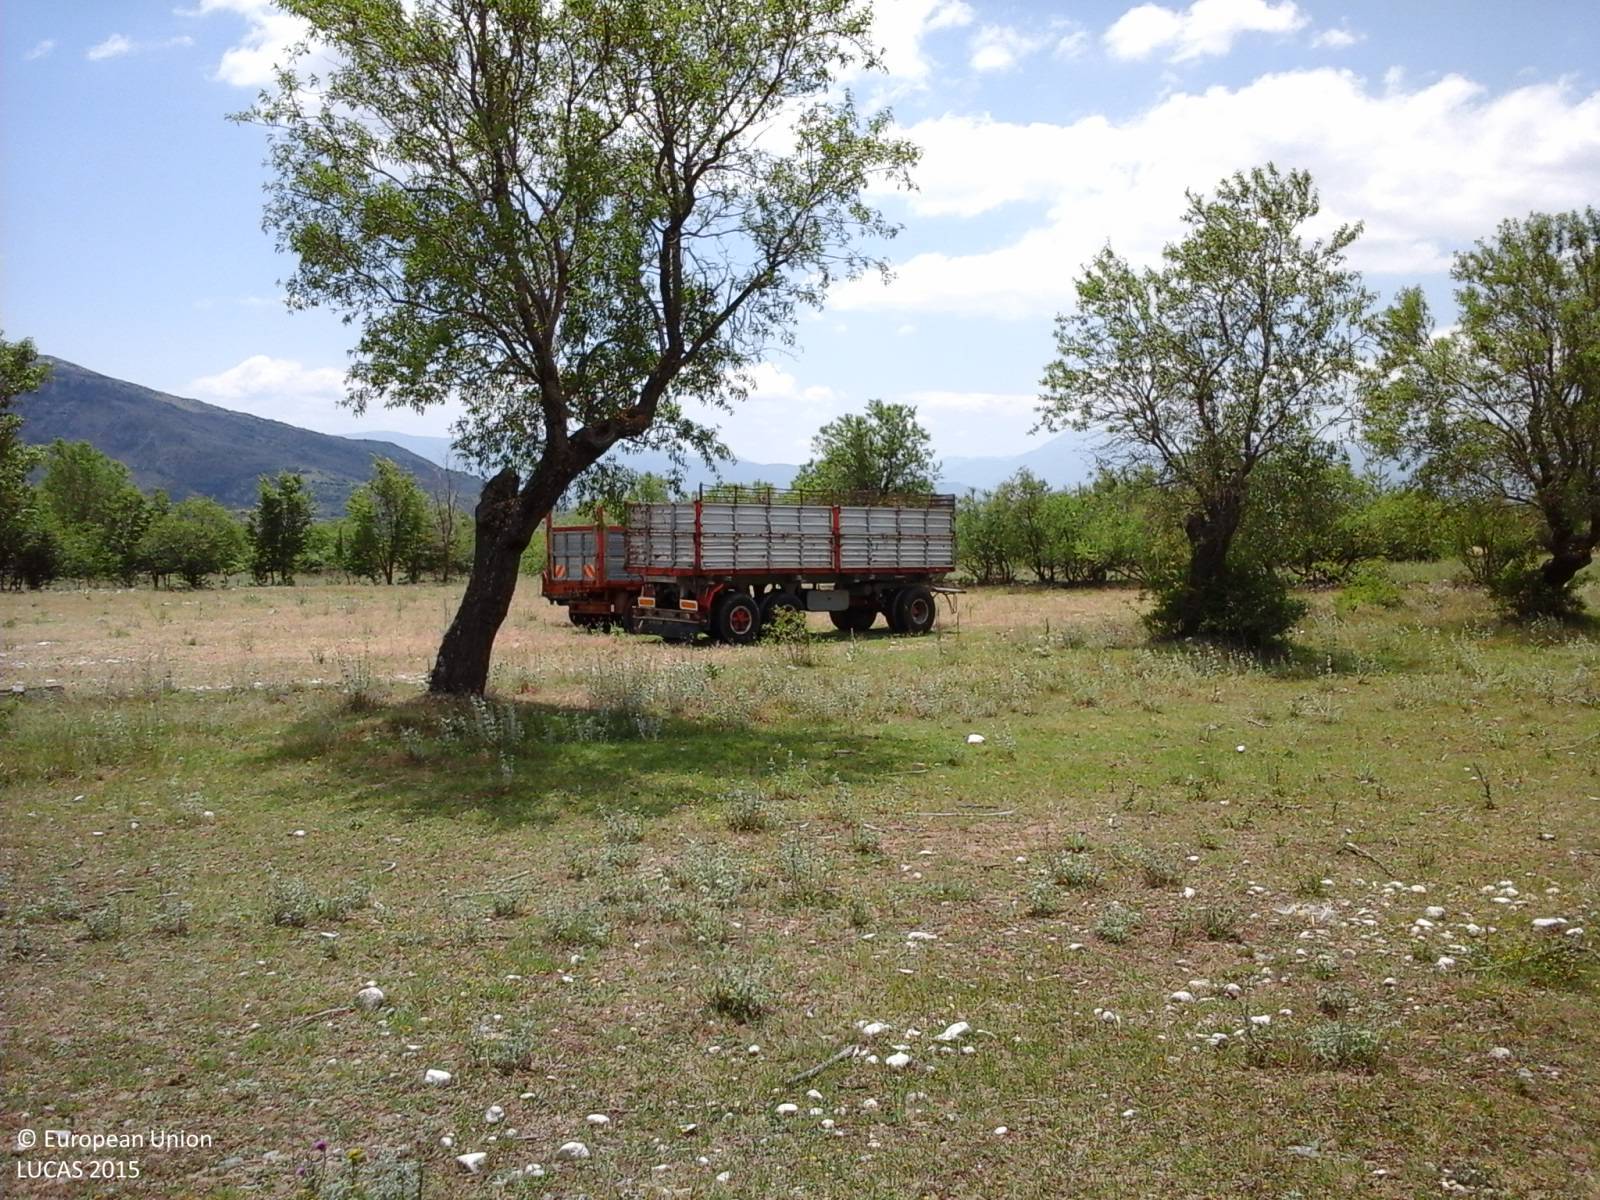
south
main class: Cropland
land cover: Nuts trees
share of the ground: > 75 %
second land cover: Grassland without tree/shrub cover
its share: > 75 %
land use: Agriculture (excluding fallow land and kitchen gardens)
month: June
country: IT
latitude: 42.1076
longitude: 13.4349
